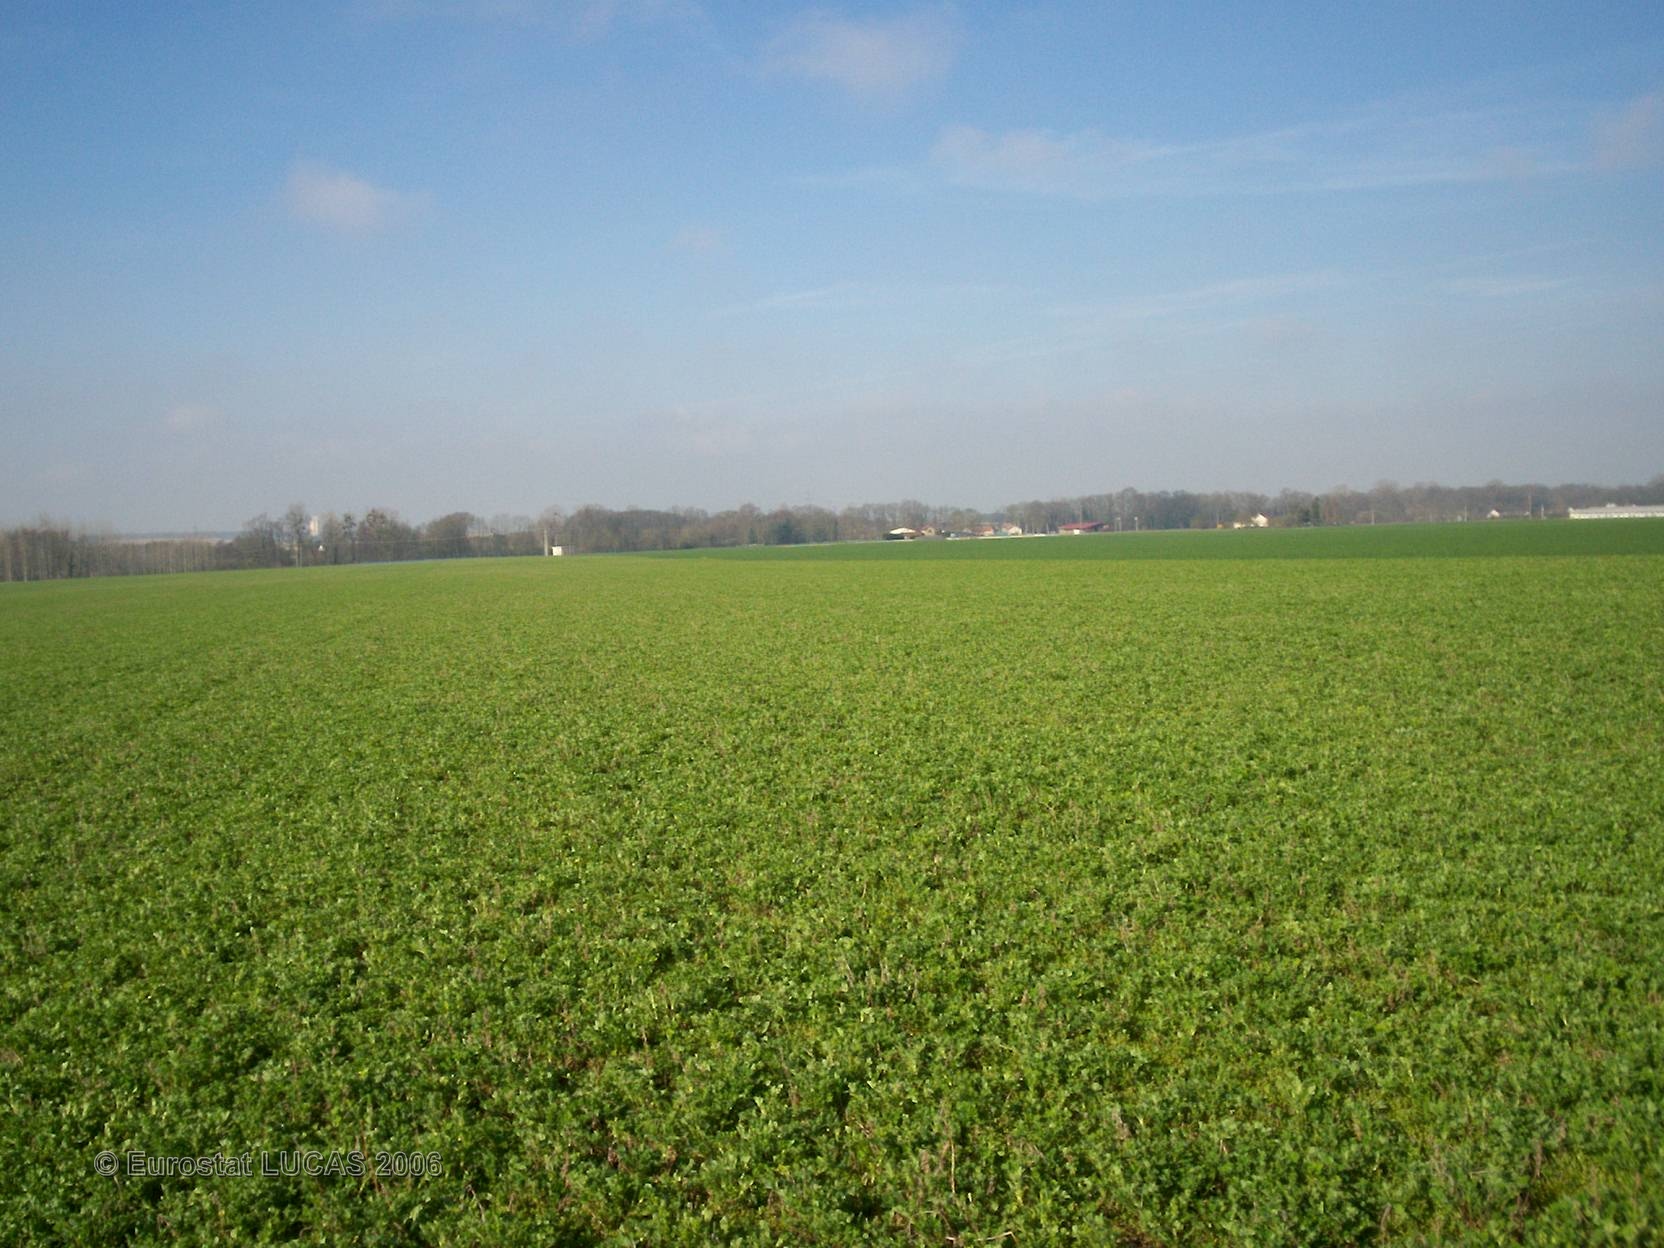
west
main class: Cropland
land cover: Lucerne
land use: Agriculture (excluding fallow land and kitchen gardens)
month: April
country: FR
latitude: 49.0896
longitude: 4.3682
